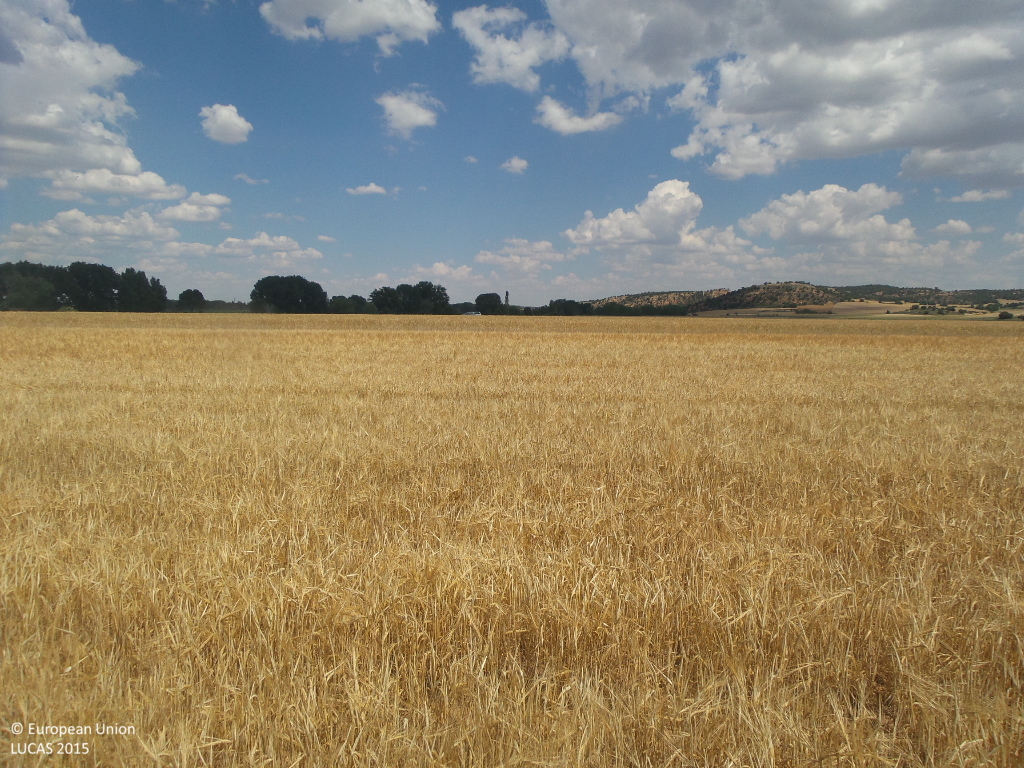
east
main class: Cropland
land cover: Barley
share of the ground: > 75 %
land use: Agriculture (excluding fallow land and kitchen gardens)
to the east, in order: Barley; Rye; Common wheat; Grass margins; Tracks; Spontaneously vegetated surfaces; Barley
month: June
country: ES
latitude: 41.4849
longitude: -2.9880
